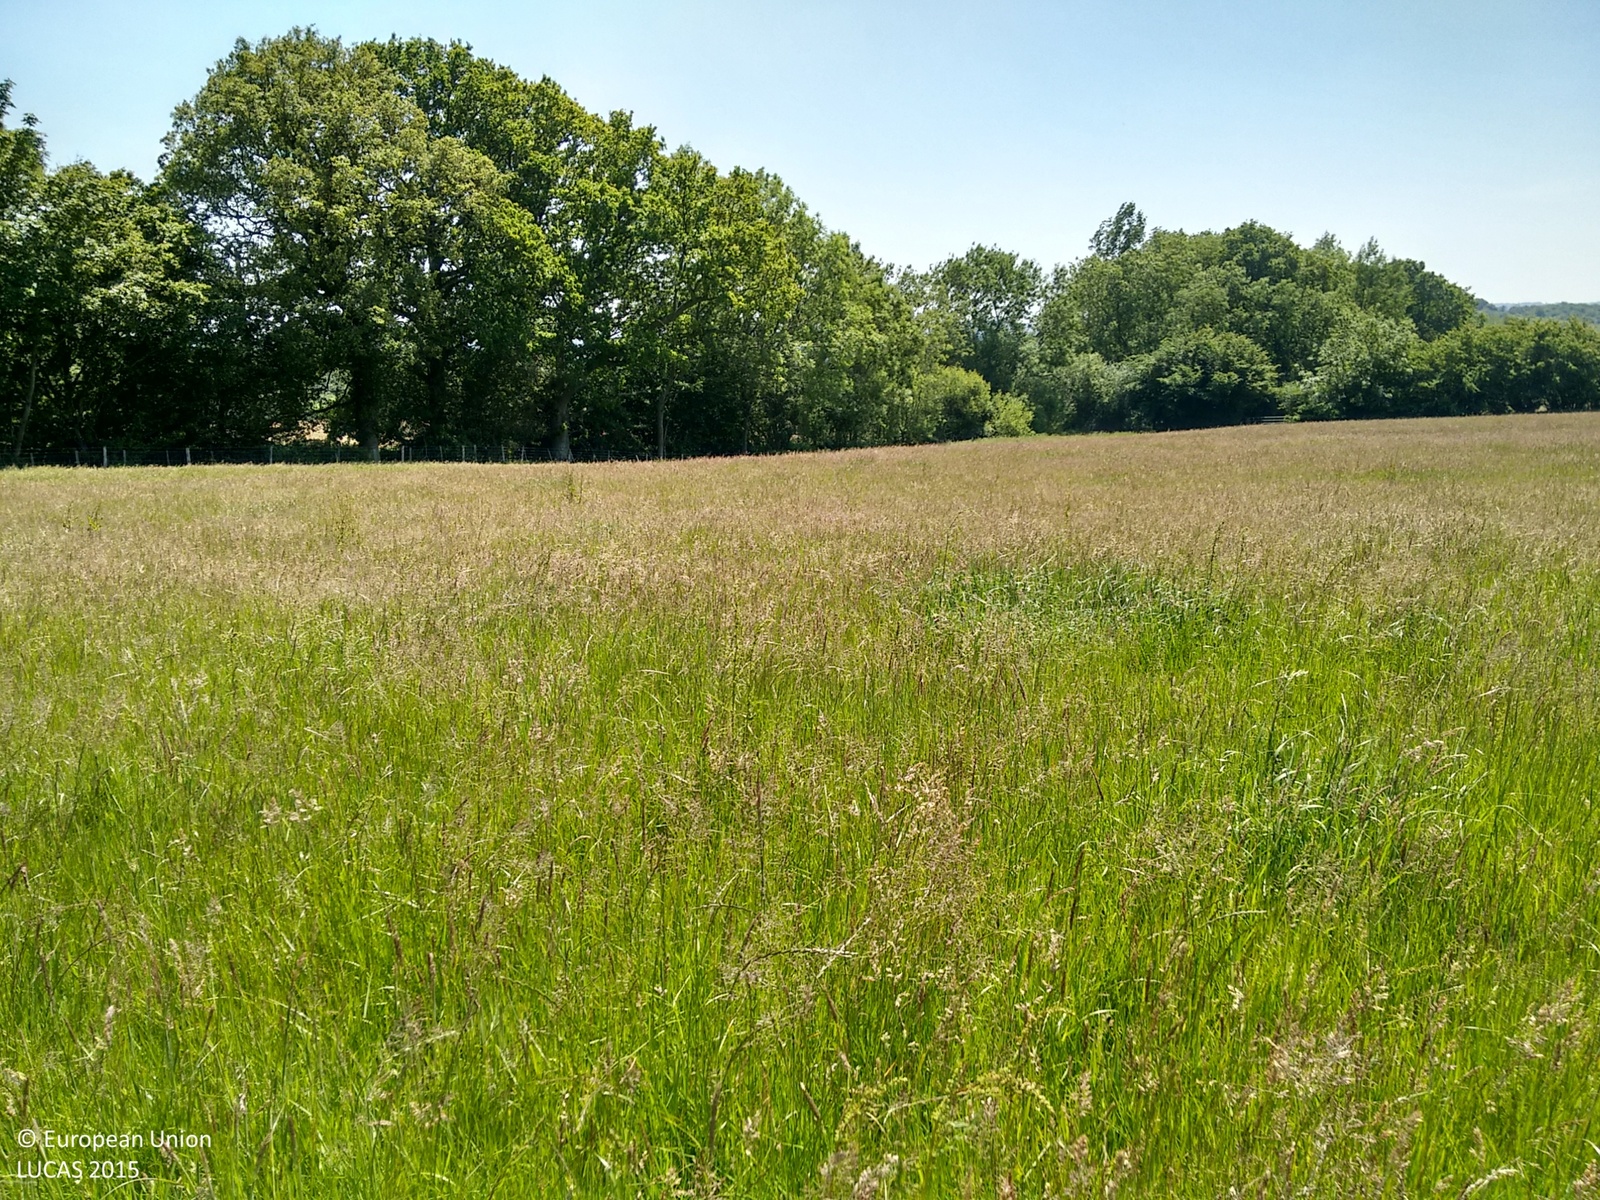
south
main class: Grassland
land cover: Grassland without tree/shrub cover
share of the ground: > 75 %
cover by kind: herbaceous plants 100 %
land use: Agriculture (excluding fallow land and kitchen gardens)
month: June
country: GB
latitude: 51.0460
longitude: 0.4002
